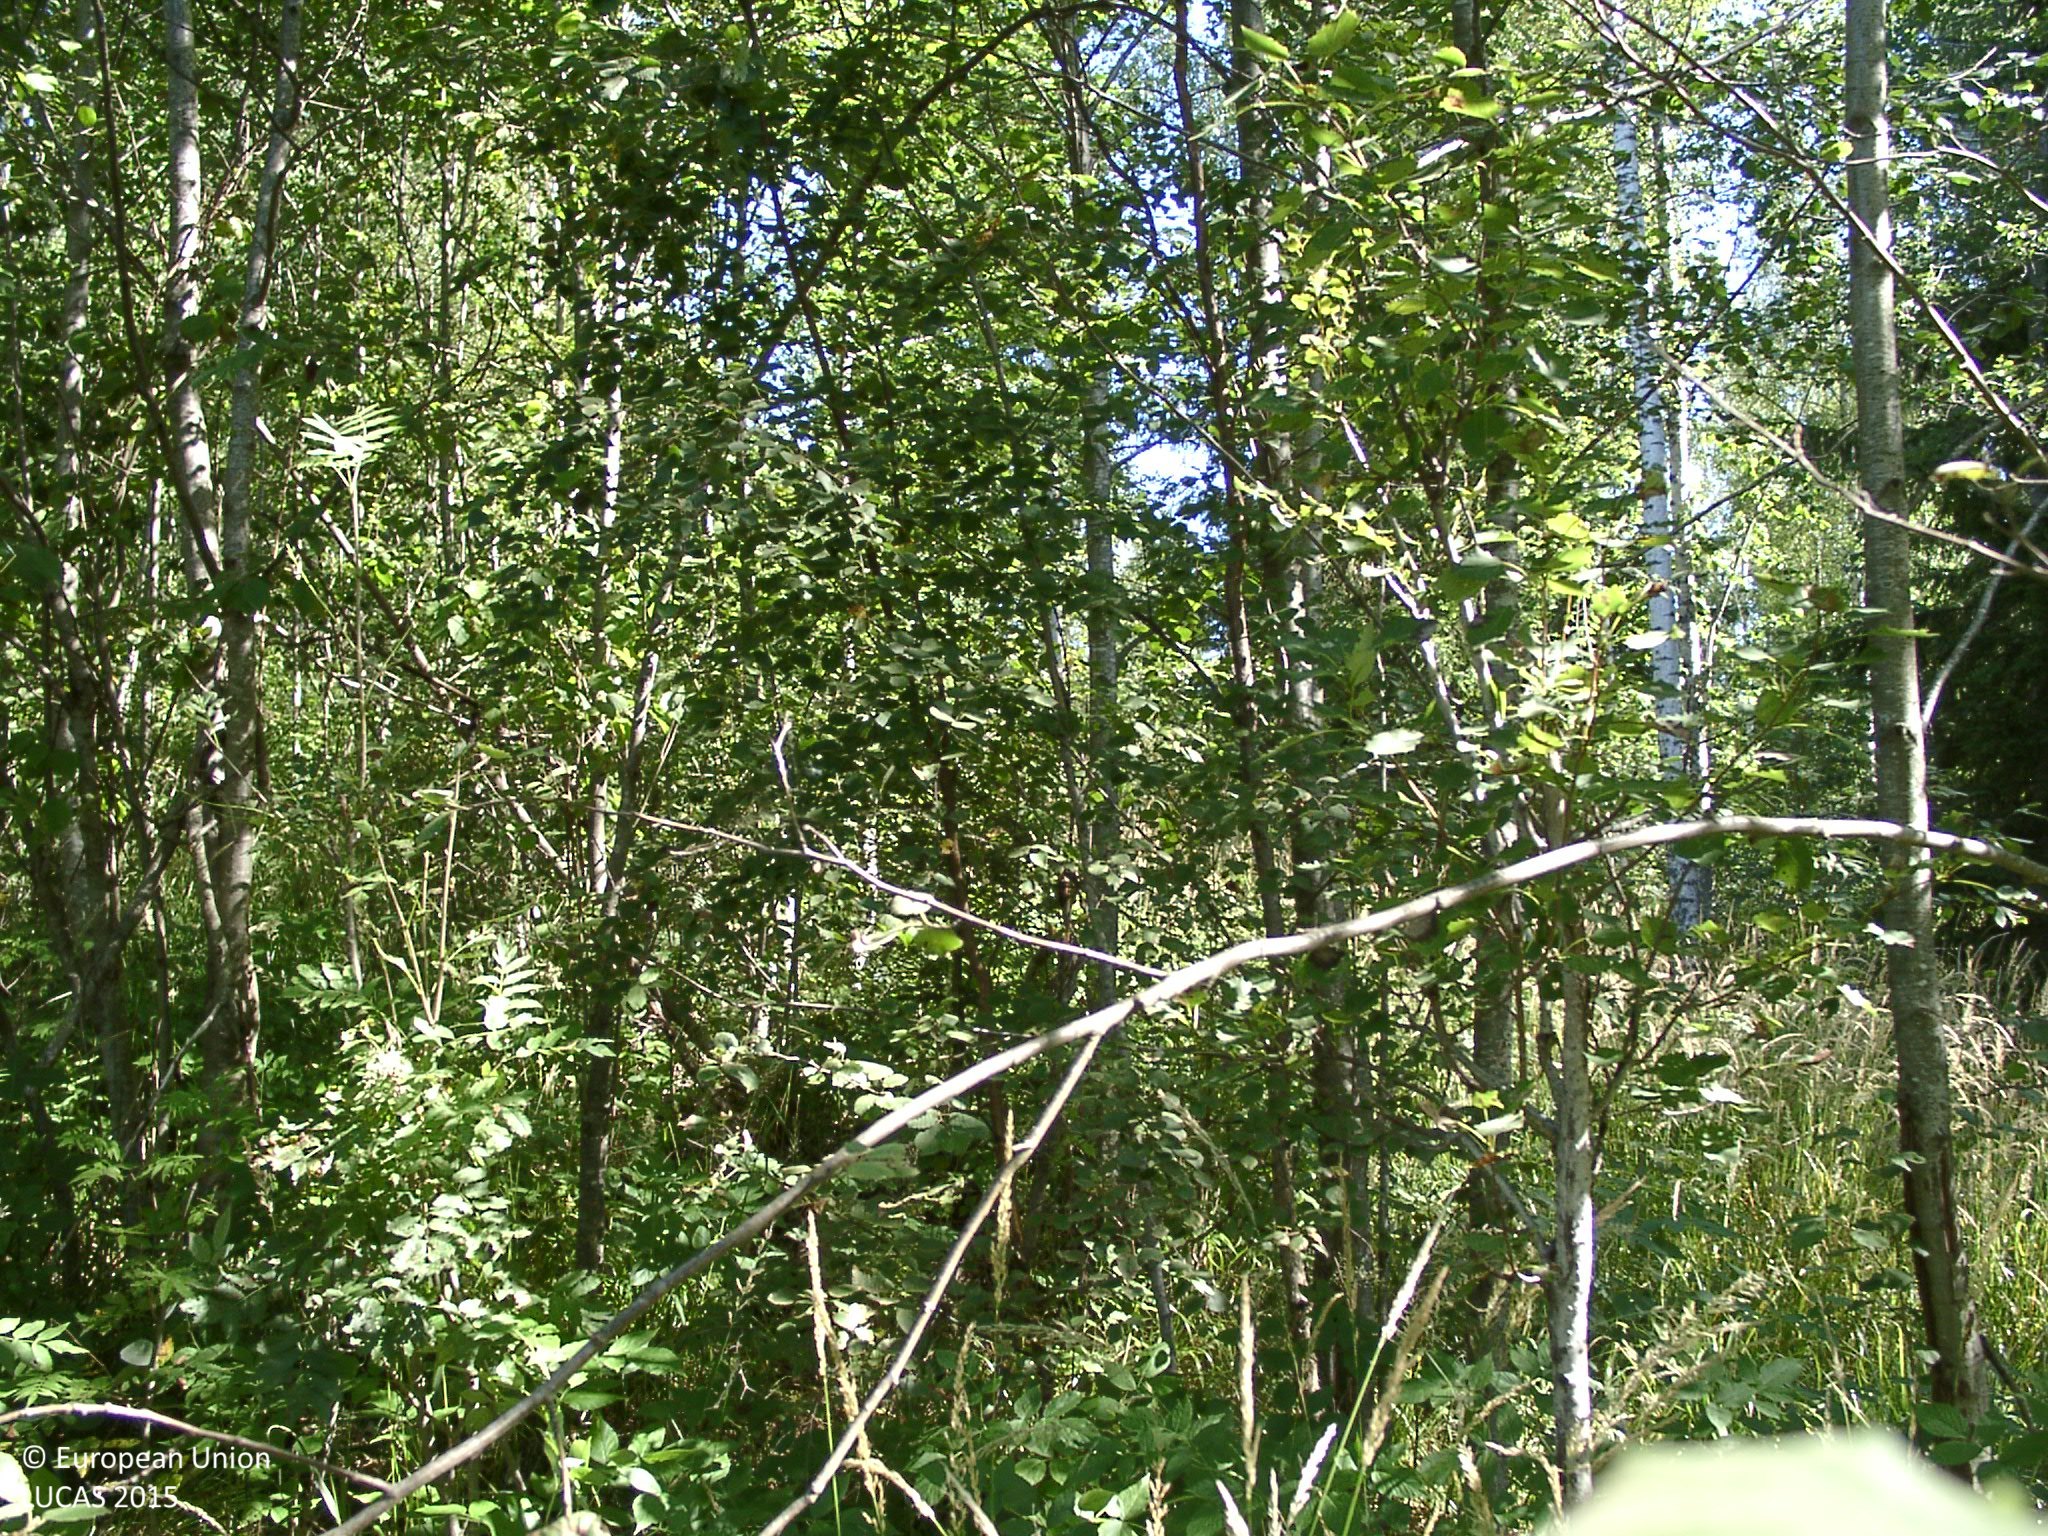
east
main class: Woodland
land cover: Broadleaved woodland
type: boreal forest
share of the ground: 50 - 75 %
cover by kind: broadleaved forest trees 50 %, herbaceous plants 25 %, coniferous forest trees 15 %, shrubs 10 %
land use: Forestry
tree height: < 5 m
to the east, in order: Broadleaved woodland; Grassland with sparse tree/shrub cover; Electric lines; Grassland with sparse tree/shrub cover; Spruce dominated mixed woodland; Peatbogs; Spruce dominated mixed woodland; Shrubland with sparse tree cover
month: August
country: FI
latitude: 61.9239
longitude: 24.8635
